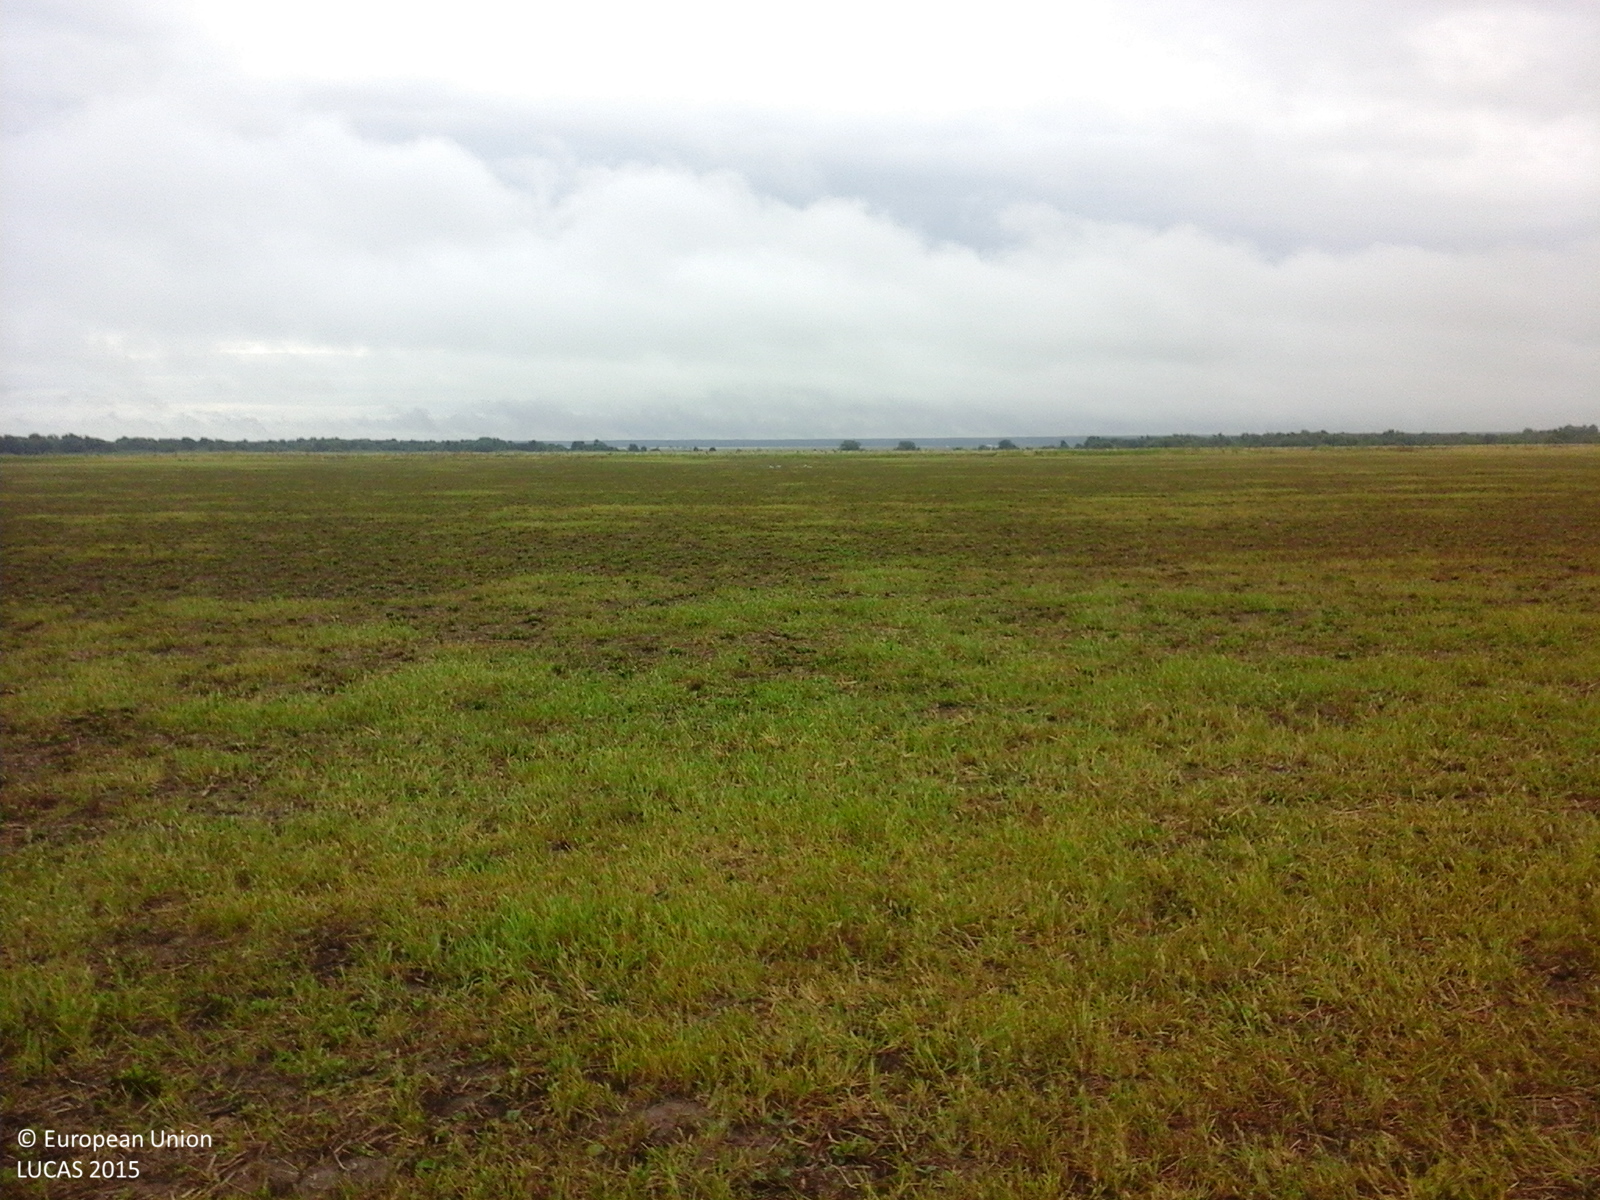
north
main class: Grassland
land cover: Grassland without tree/shrub cover
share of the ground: > 75 %
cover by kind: herbaceous plants 100 %
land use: Agriculture (excluding fallow land and kitchen gardens)
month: August
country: RO
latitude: 45.6362
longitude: 21.5148
